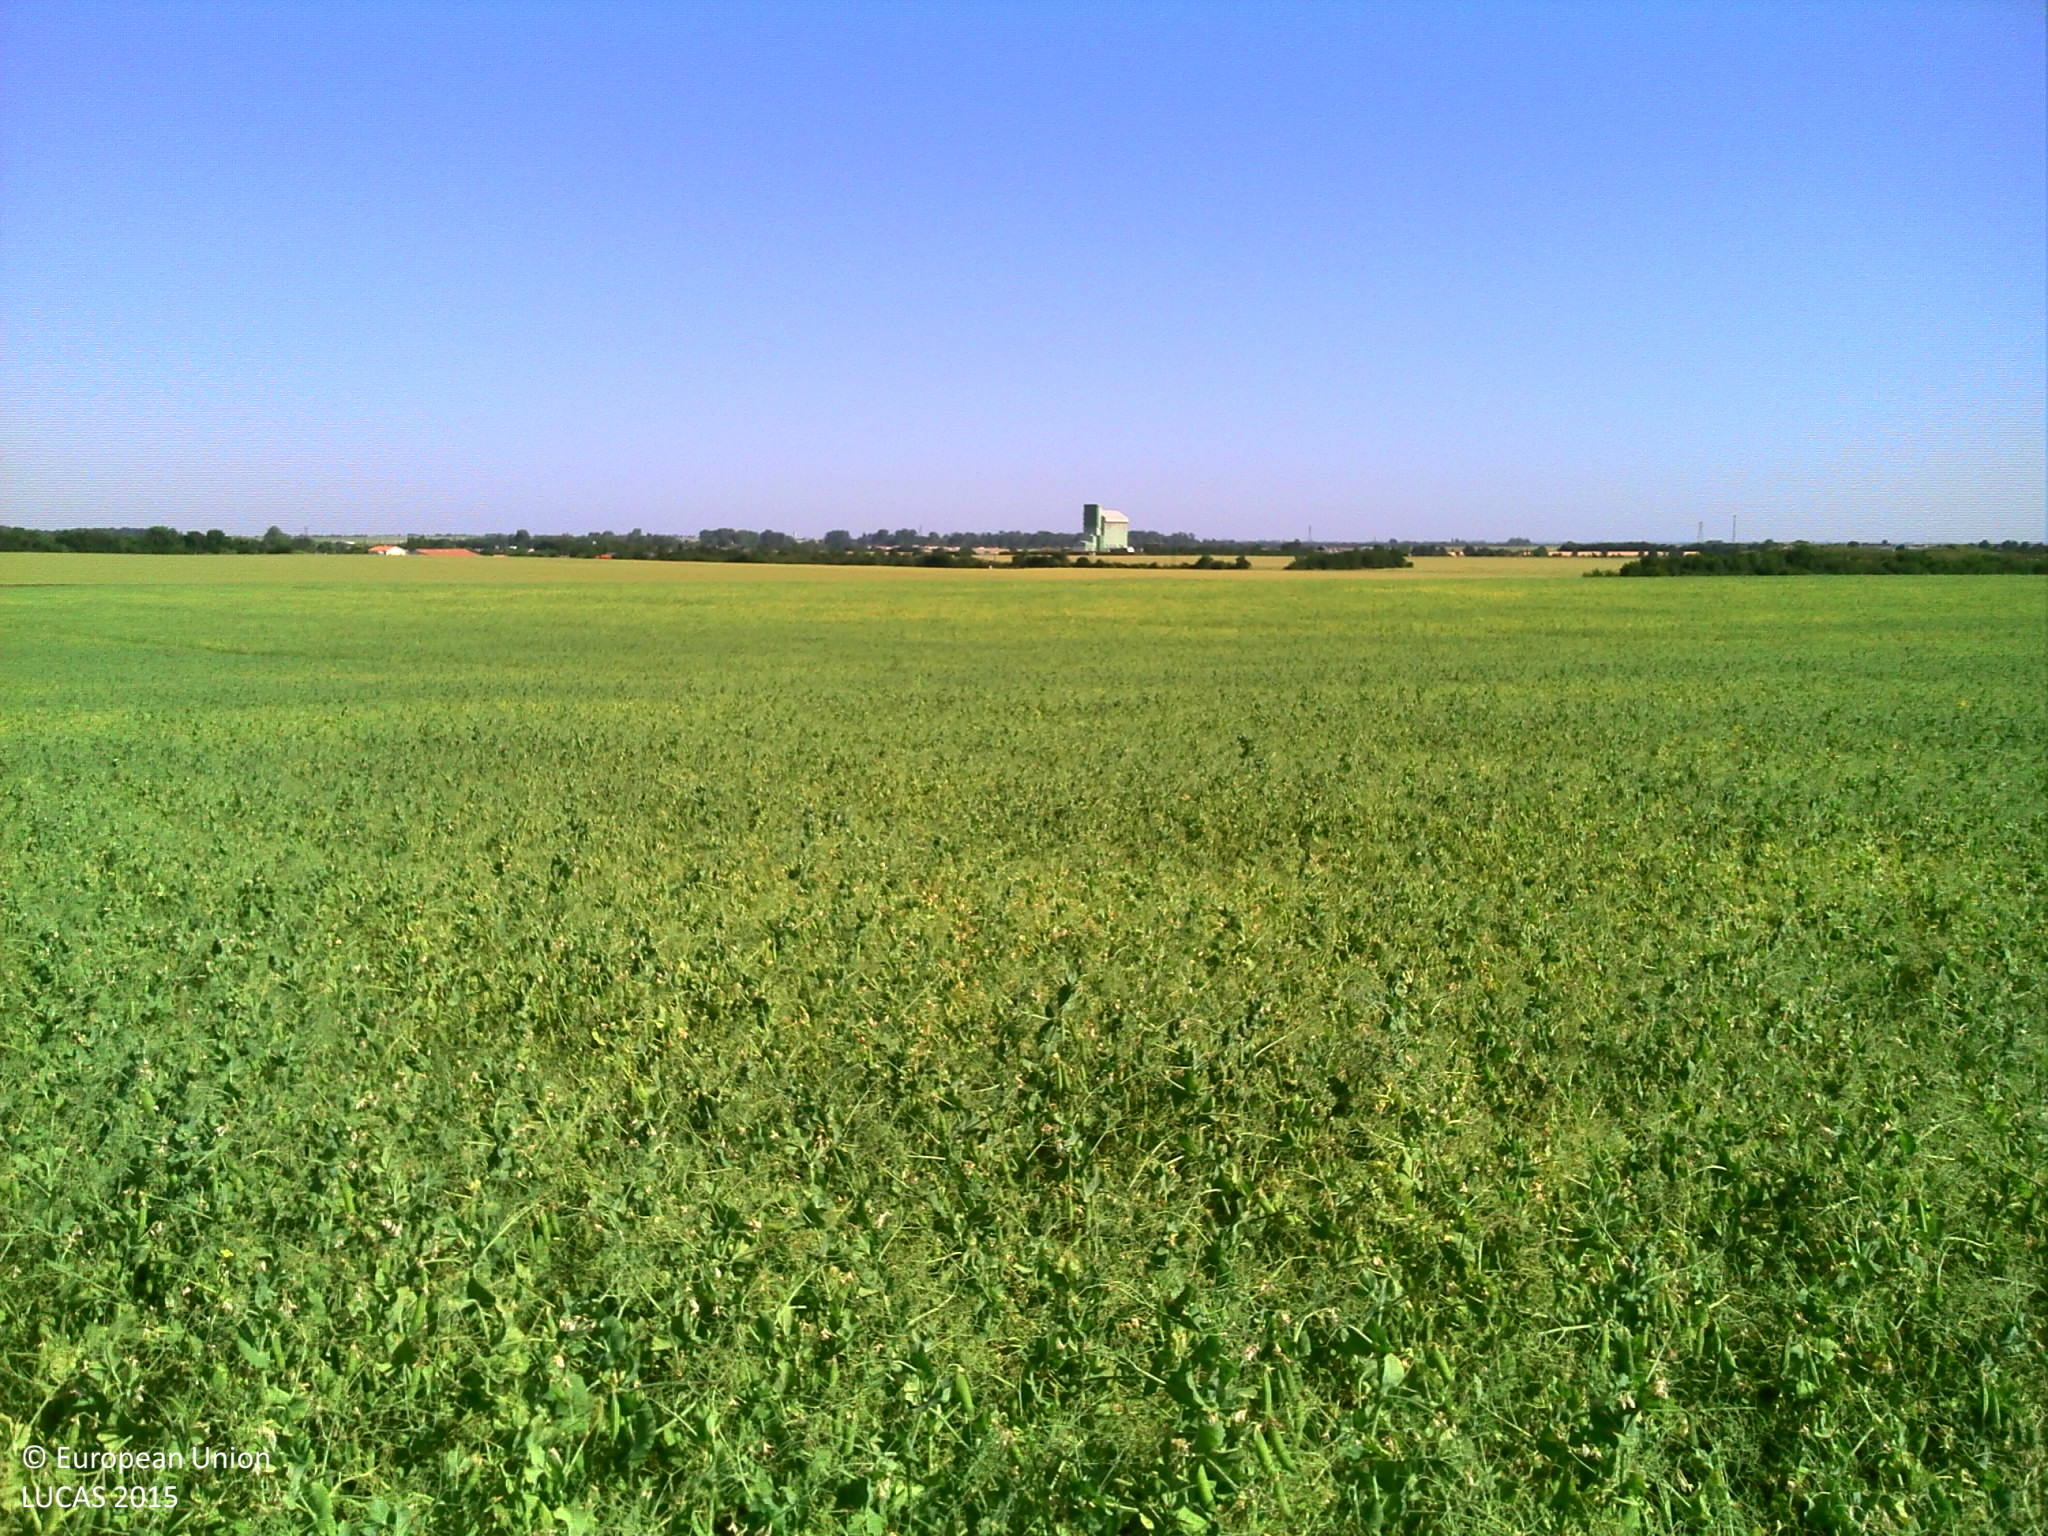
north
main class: Cropland
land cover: Dry pulses
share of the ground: > 75 %
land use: Agriculture (excluding fallow land and kitchen gardens)
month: June
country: FR
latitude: 46.2019
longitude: -0.9811
